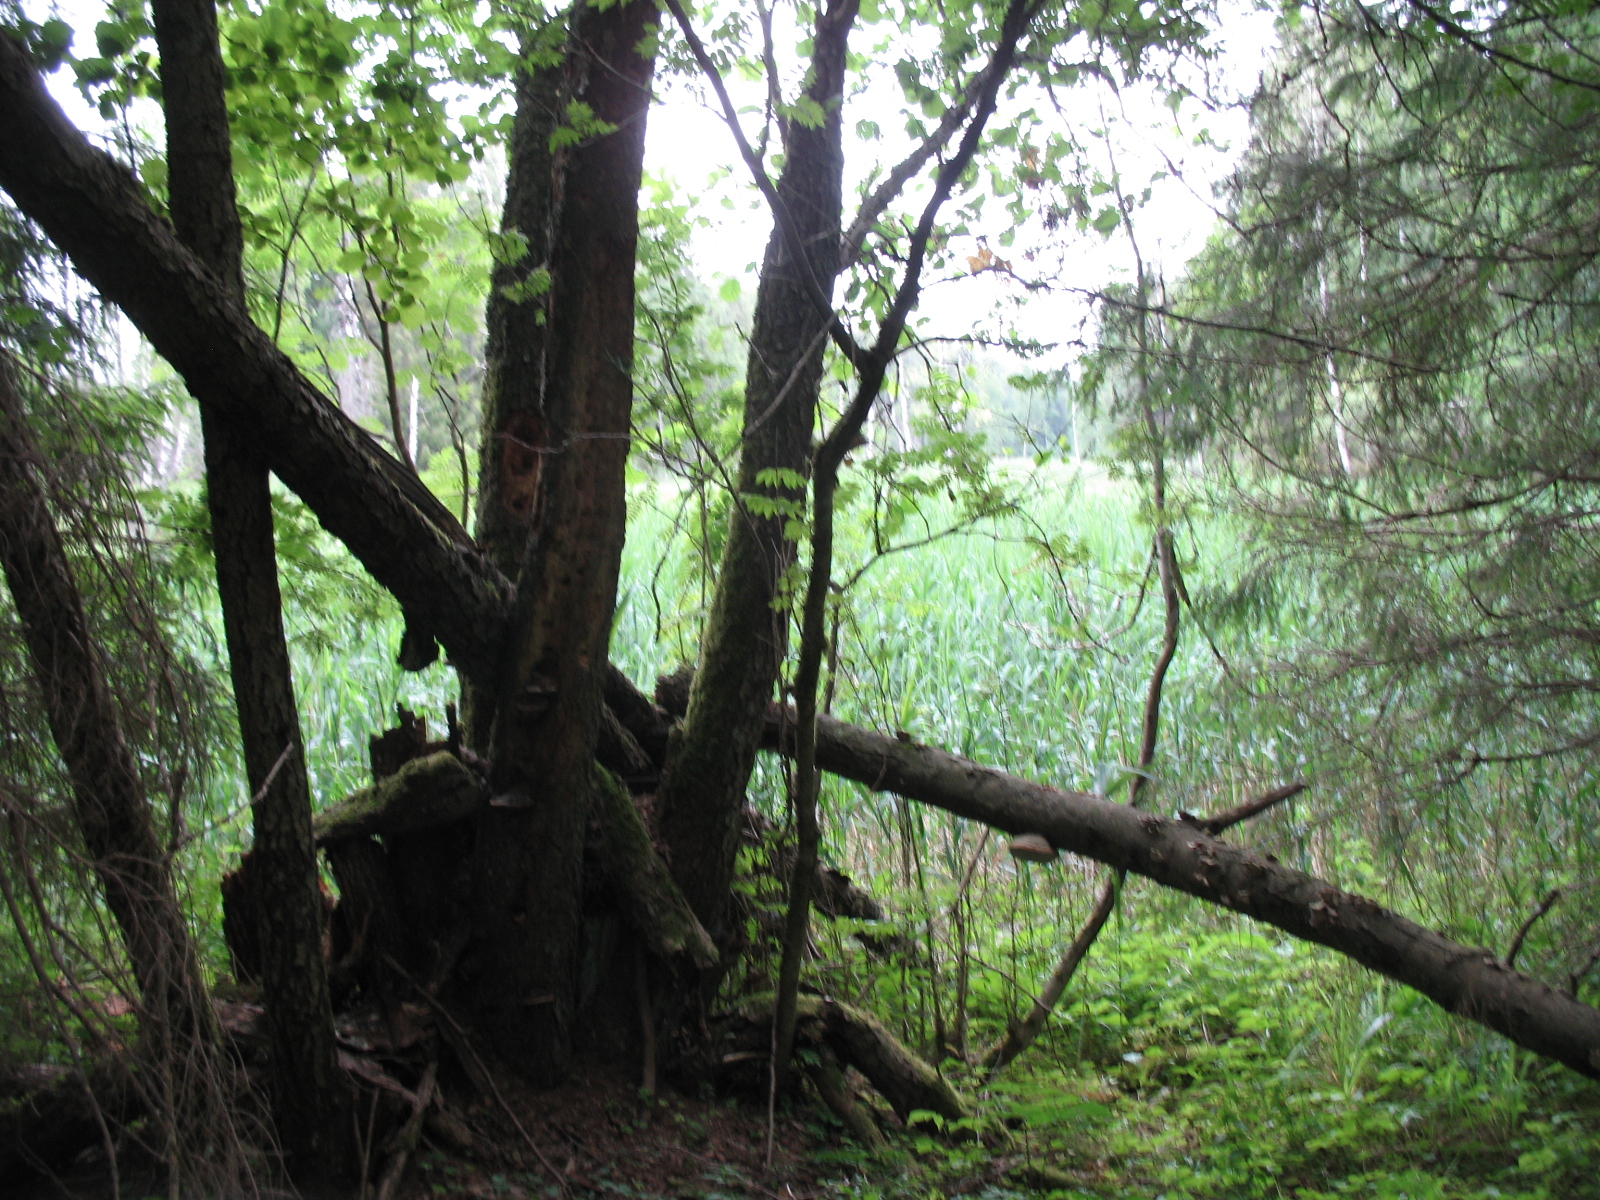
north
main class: Woodland
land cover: Other coniferous woodland
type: hemiboreal forest and nemoral coniferous forest and mixed broadleaved-coniferous forest
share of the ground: > 75 %
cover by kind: coniferous forest trees 80 %, broadleaved forest trees 10 %, herbaceous plants 5 %, lichens and mosses 5 %
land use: Forestry
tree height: > 5 m
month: July
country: LV
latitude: 56.7495
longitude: 23.8334
